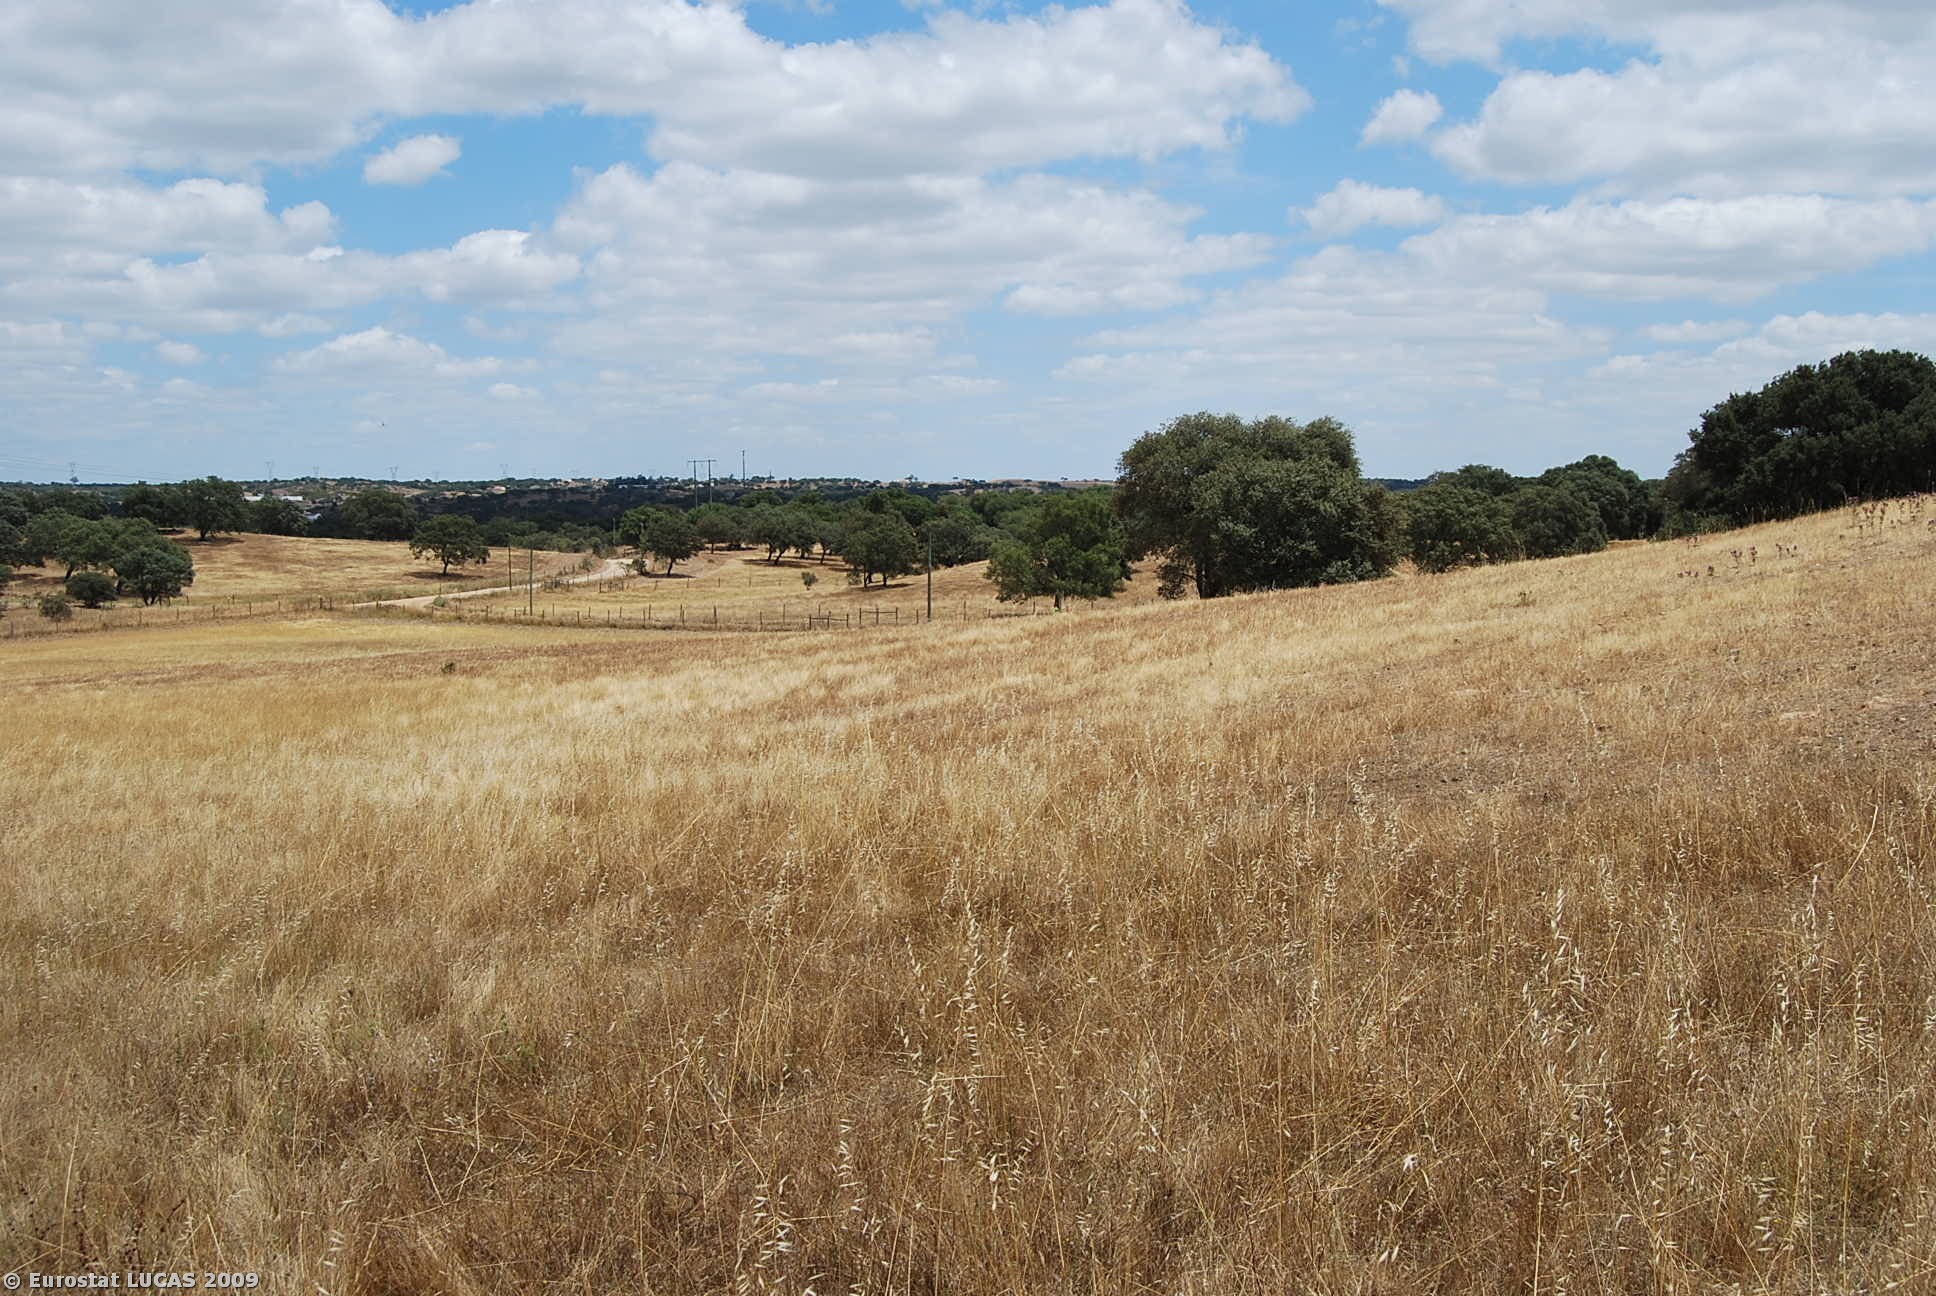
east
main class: Grassland
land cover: Grassland without tree/shrub cover
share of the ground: > 75 %
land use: Agriculture (excluding fallow land and kitchen gardens)
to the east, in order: Grassland without tree/shrub cover; Lines of trees; Spontaneously vegetated surfaces; Other structural elements; Fences; Tracks; Other structural elements; Fences; Bare land; Broadleaved woodland
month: June
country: PT
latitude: 37.9950
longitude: -8.5717
